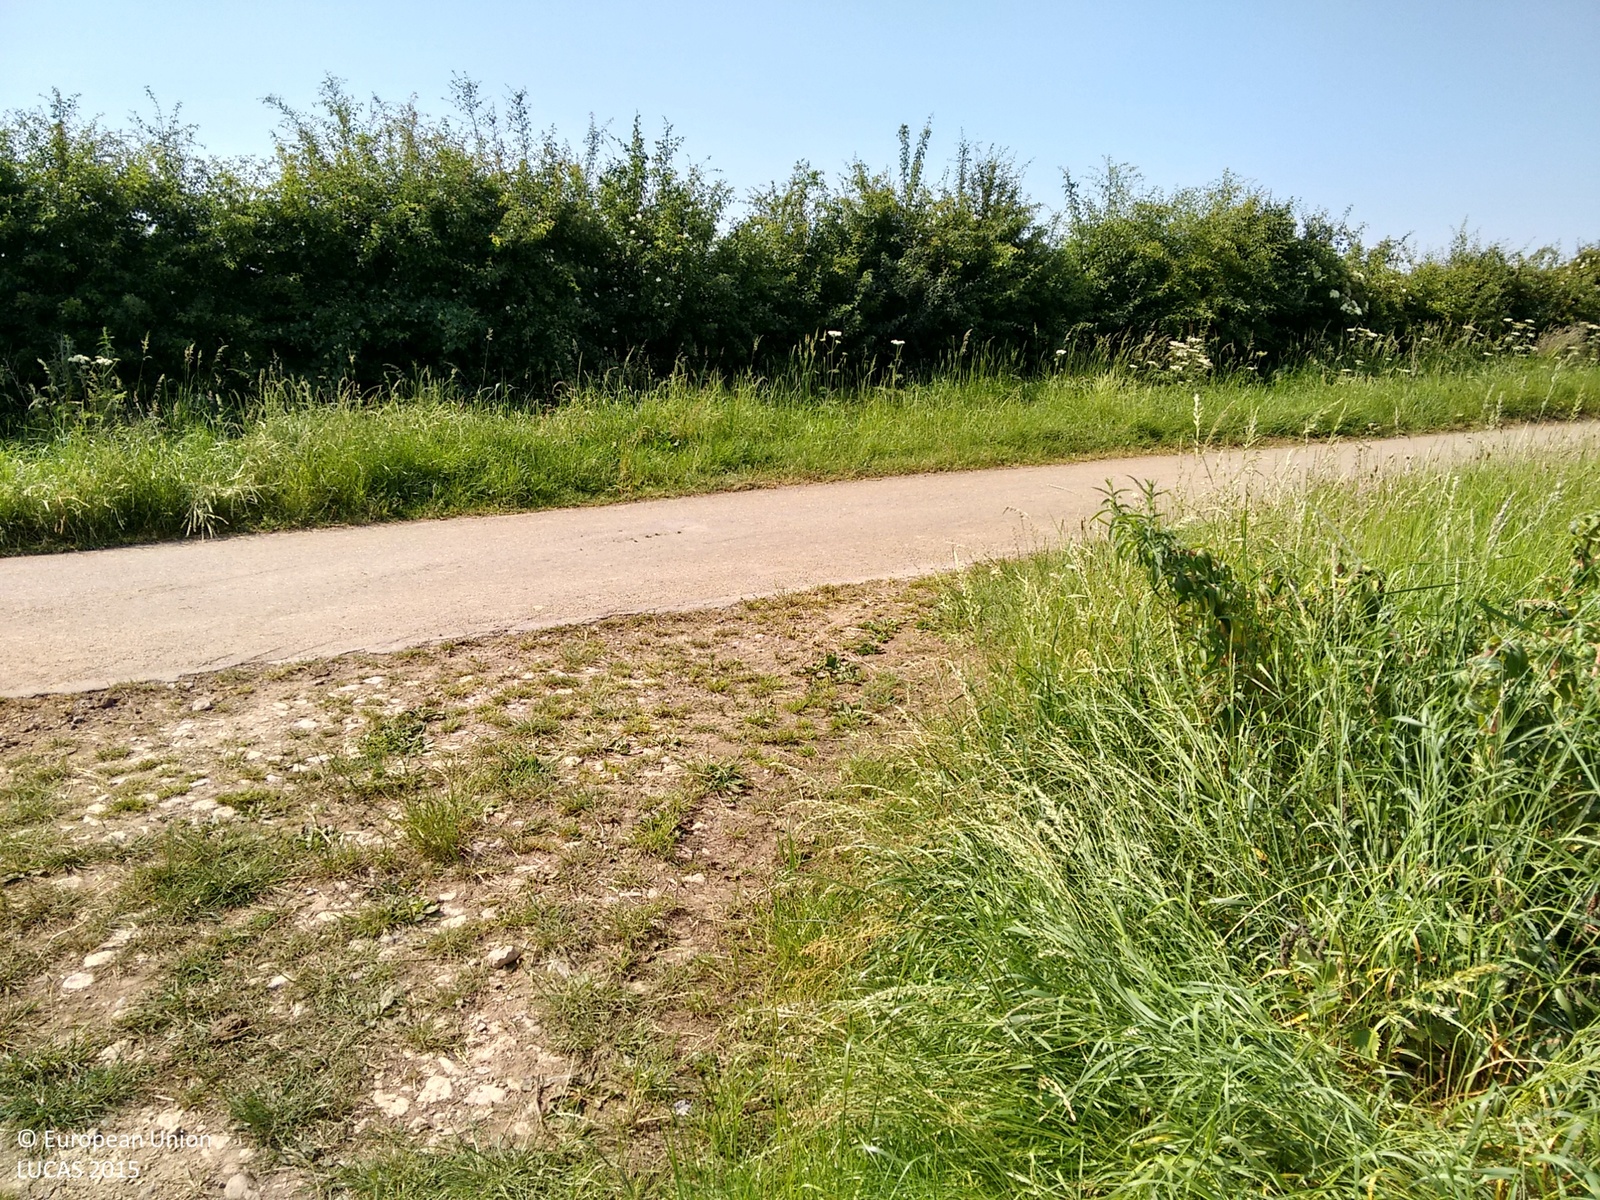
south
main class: Grassland
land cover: Grassland without tree/shrub cover
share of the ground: > 75 %
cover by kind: herbaceous plants 100 %
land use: Agriculture (excluding fallow land and kitchen gardens)
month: July
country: GB
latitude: 53.4005
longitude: -0.6728
